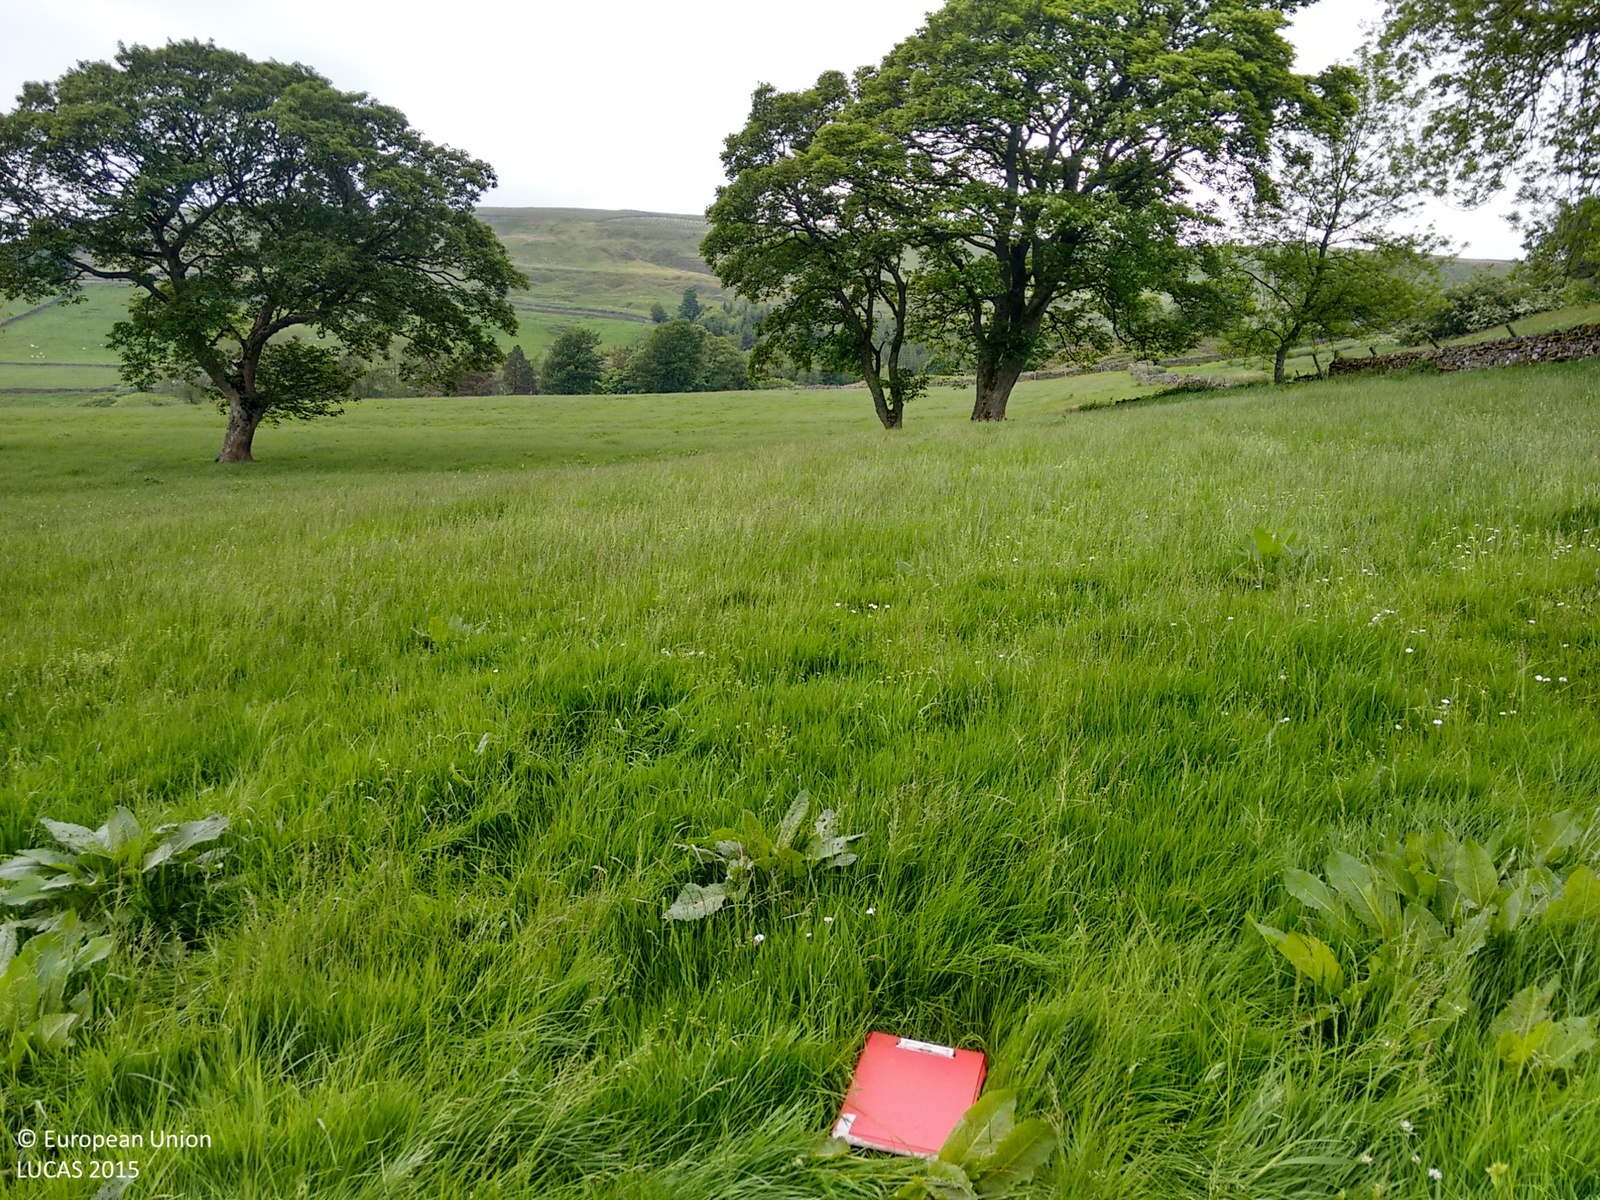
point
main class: Grassland
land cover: Grassland without tree/shrub cover
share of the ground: > 75 %
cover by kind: herbaceous plants 100 %
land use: Agriculture (excluding fallow land and kitchen gardens)
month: June
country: GB
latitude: 54.8183
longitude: -2.4026
